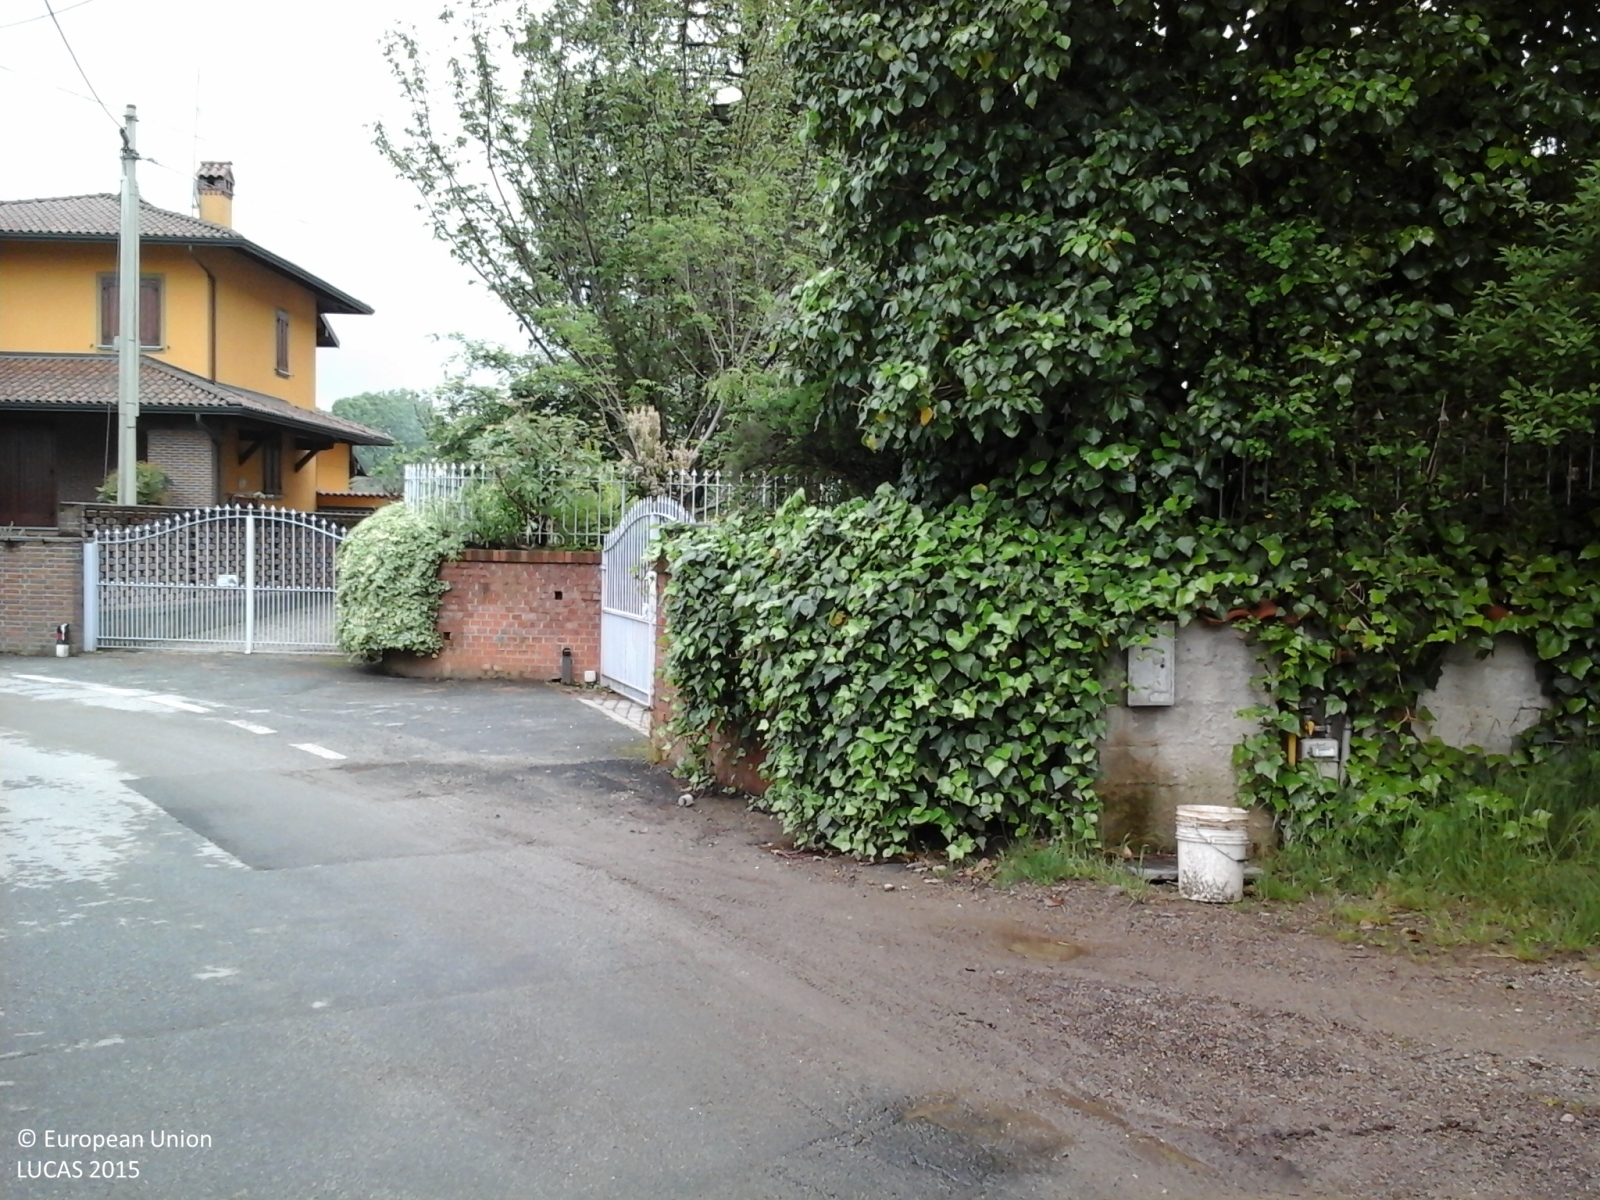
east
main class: Grassland
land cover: Grassland with sparse tree/shrub cover
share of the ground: > 75 %
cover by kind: herbaceous plants 95 %, broadleaved forest trees 5 %
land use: Residential
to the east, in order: Grassland with sparse tree/shrub cover; Artificial constructions in urban areas; Other bare soil; Other fruit trees and berries; Fences; Broadleaved woodland
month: May
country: IT
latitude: 45.6574
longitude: 8.6034
